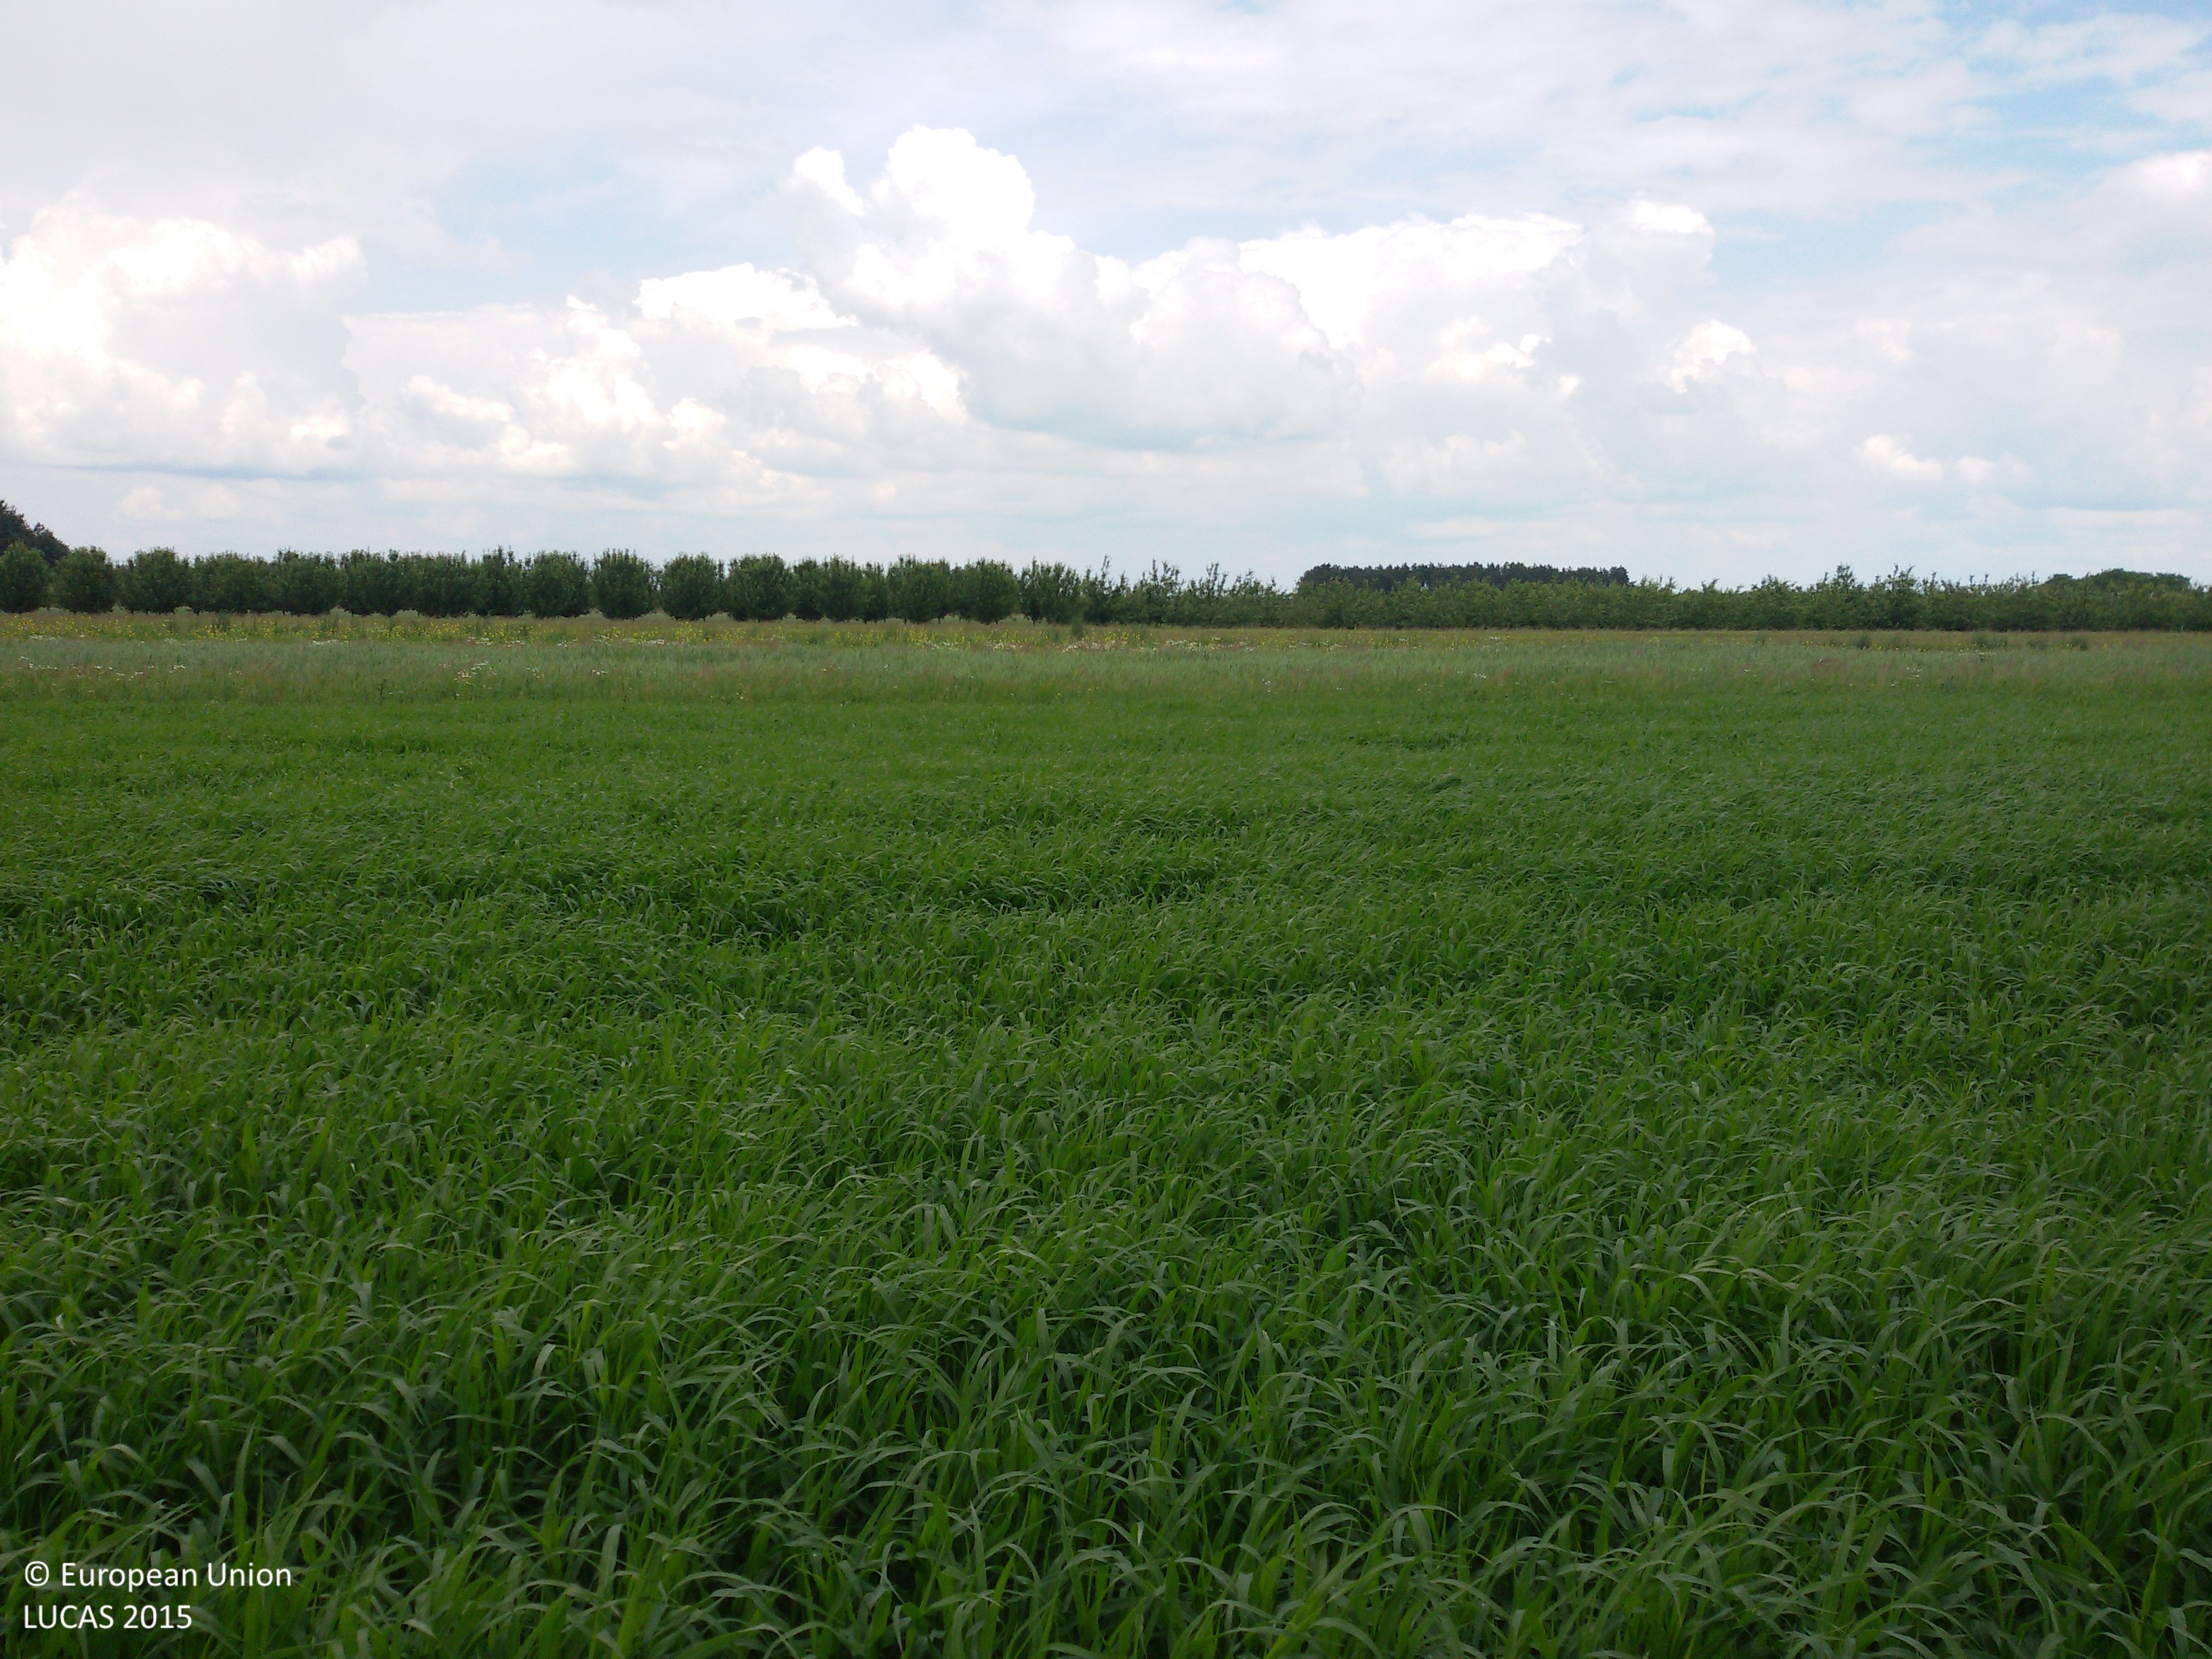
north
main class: Cropland
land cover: Rye
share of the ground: > 75 %
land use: Agriculture (excluding fallow land and kitchen gardens)
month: June
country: PL
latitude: 51.0271
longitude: 21.7606
